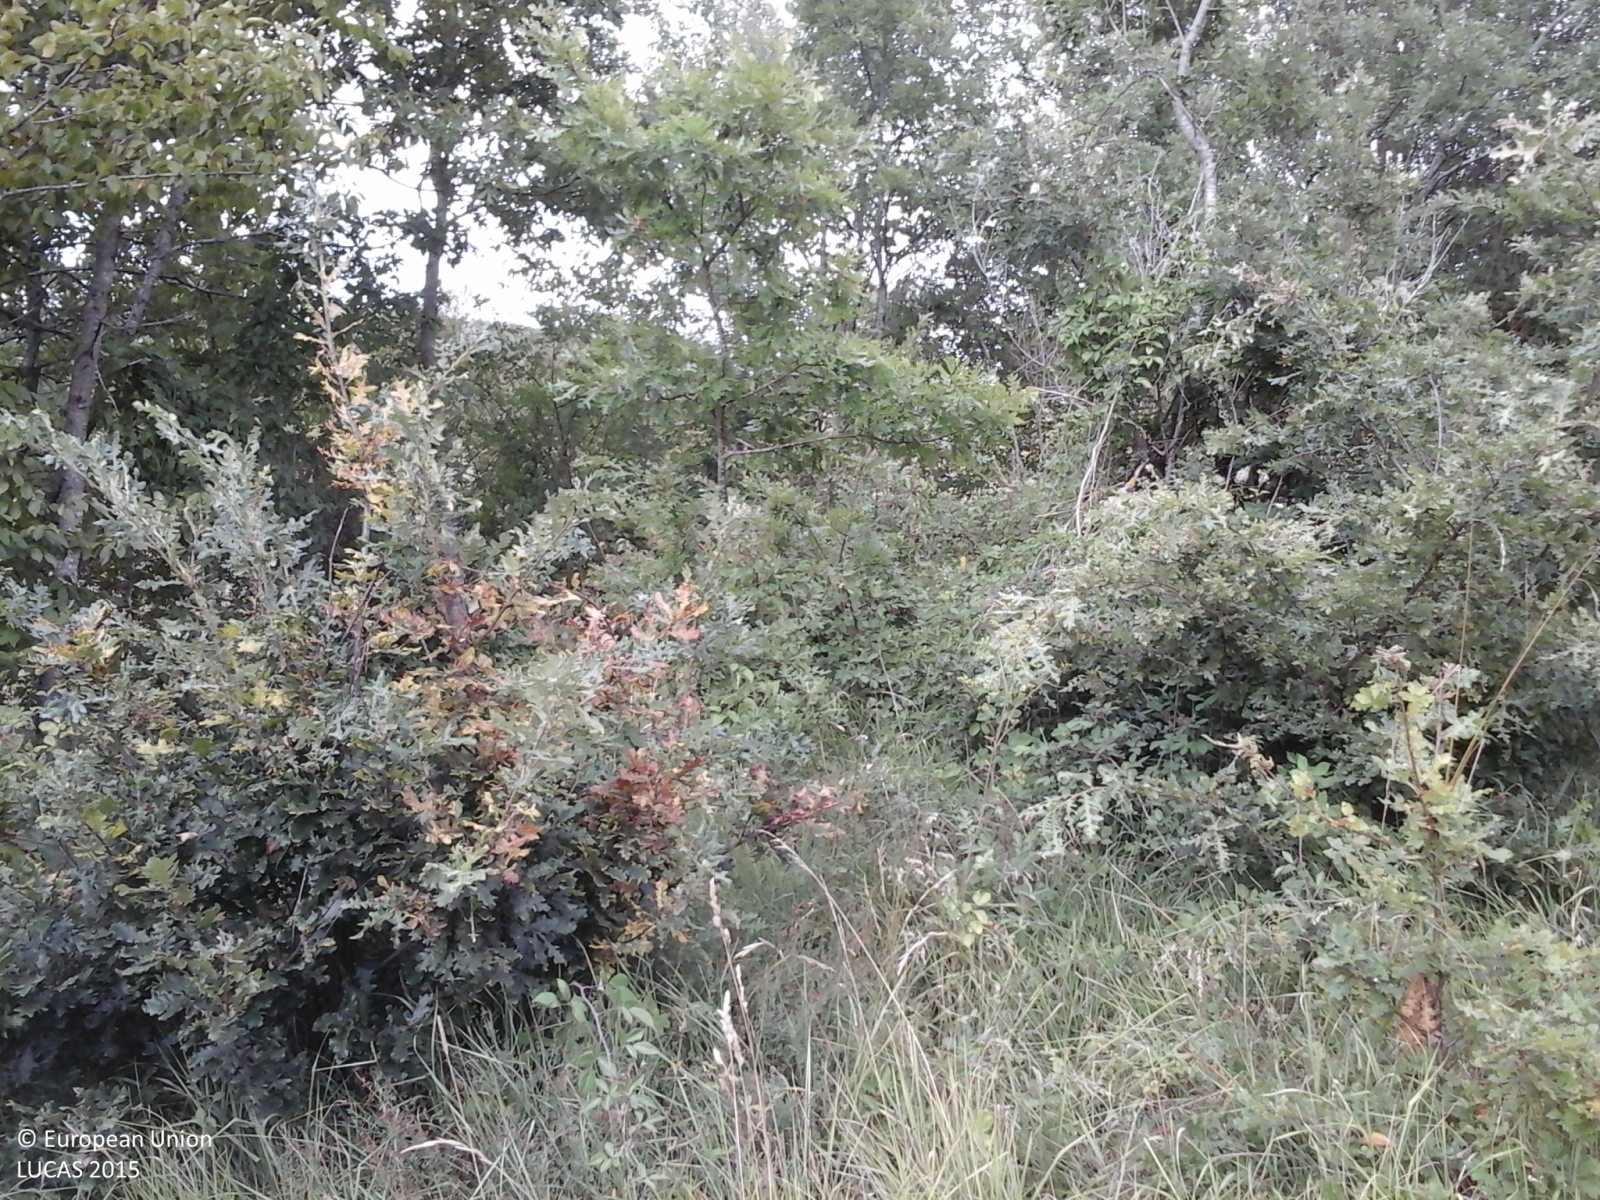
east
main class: Woodland
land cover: Broadleaved woodland
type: thermophilous deciduous forest
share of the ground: > 75 %
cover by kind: herbaceous plants 50 %, broadleaved forest trees 45 %, shrubs 5 %
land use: Agriculture (excluding fallow land and kitchen gardens)
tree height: < 5 m
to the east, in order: Broadleaved woodland; Grassland without tree/shrub cover; Grassland with sparse tree/shrub cover; Broadleaved woodland; Grassland without tree/shrub cover
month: August
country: IT
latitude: 41.6965
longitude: 14.2508
